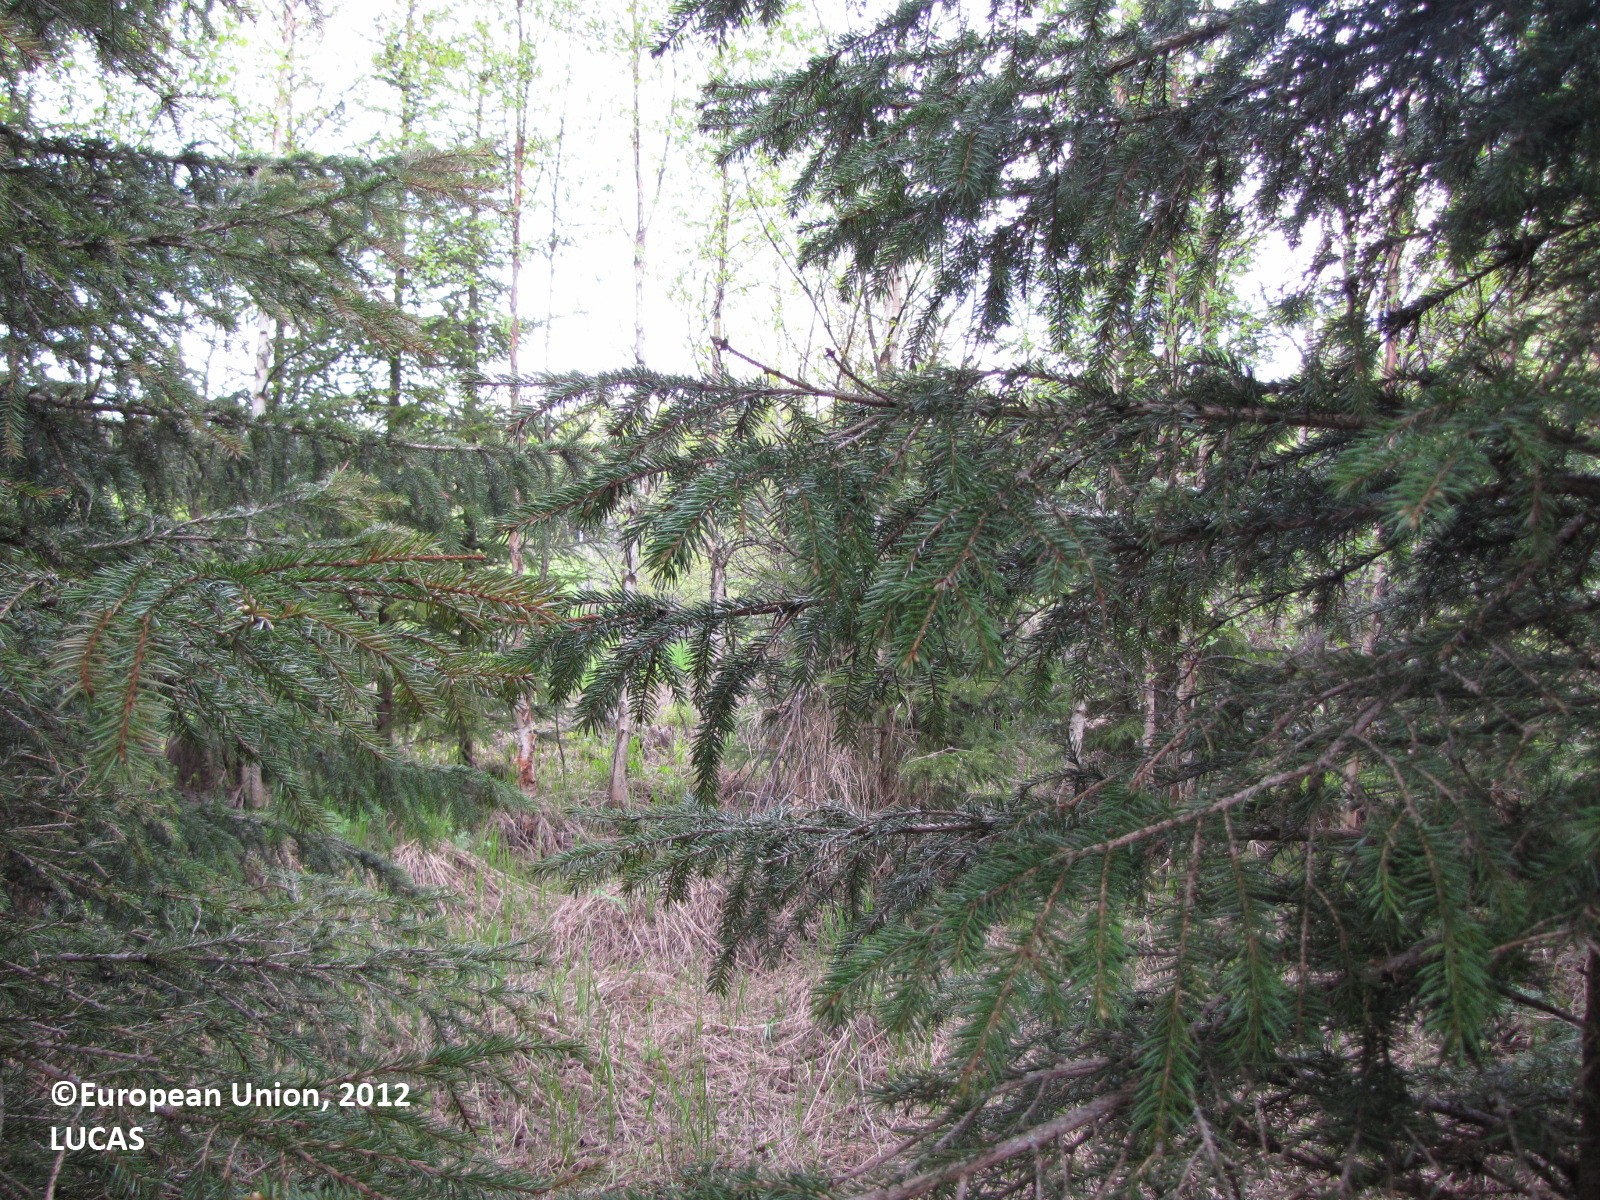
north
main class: Woodland
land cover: Spruce dominated coniferous woodland
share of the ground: > 75 %
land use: Forestry
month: June
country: FI
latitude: 65.8361
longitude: 24.4357
